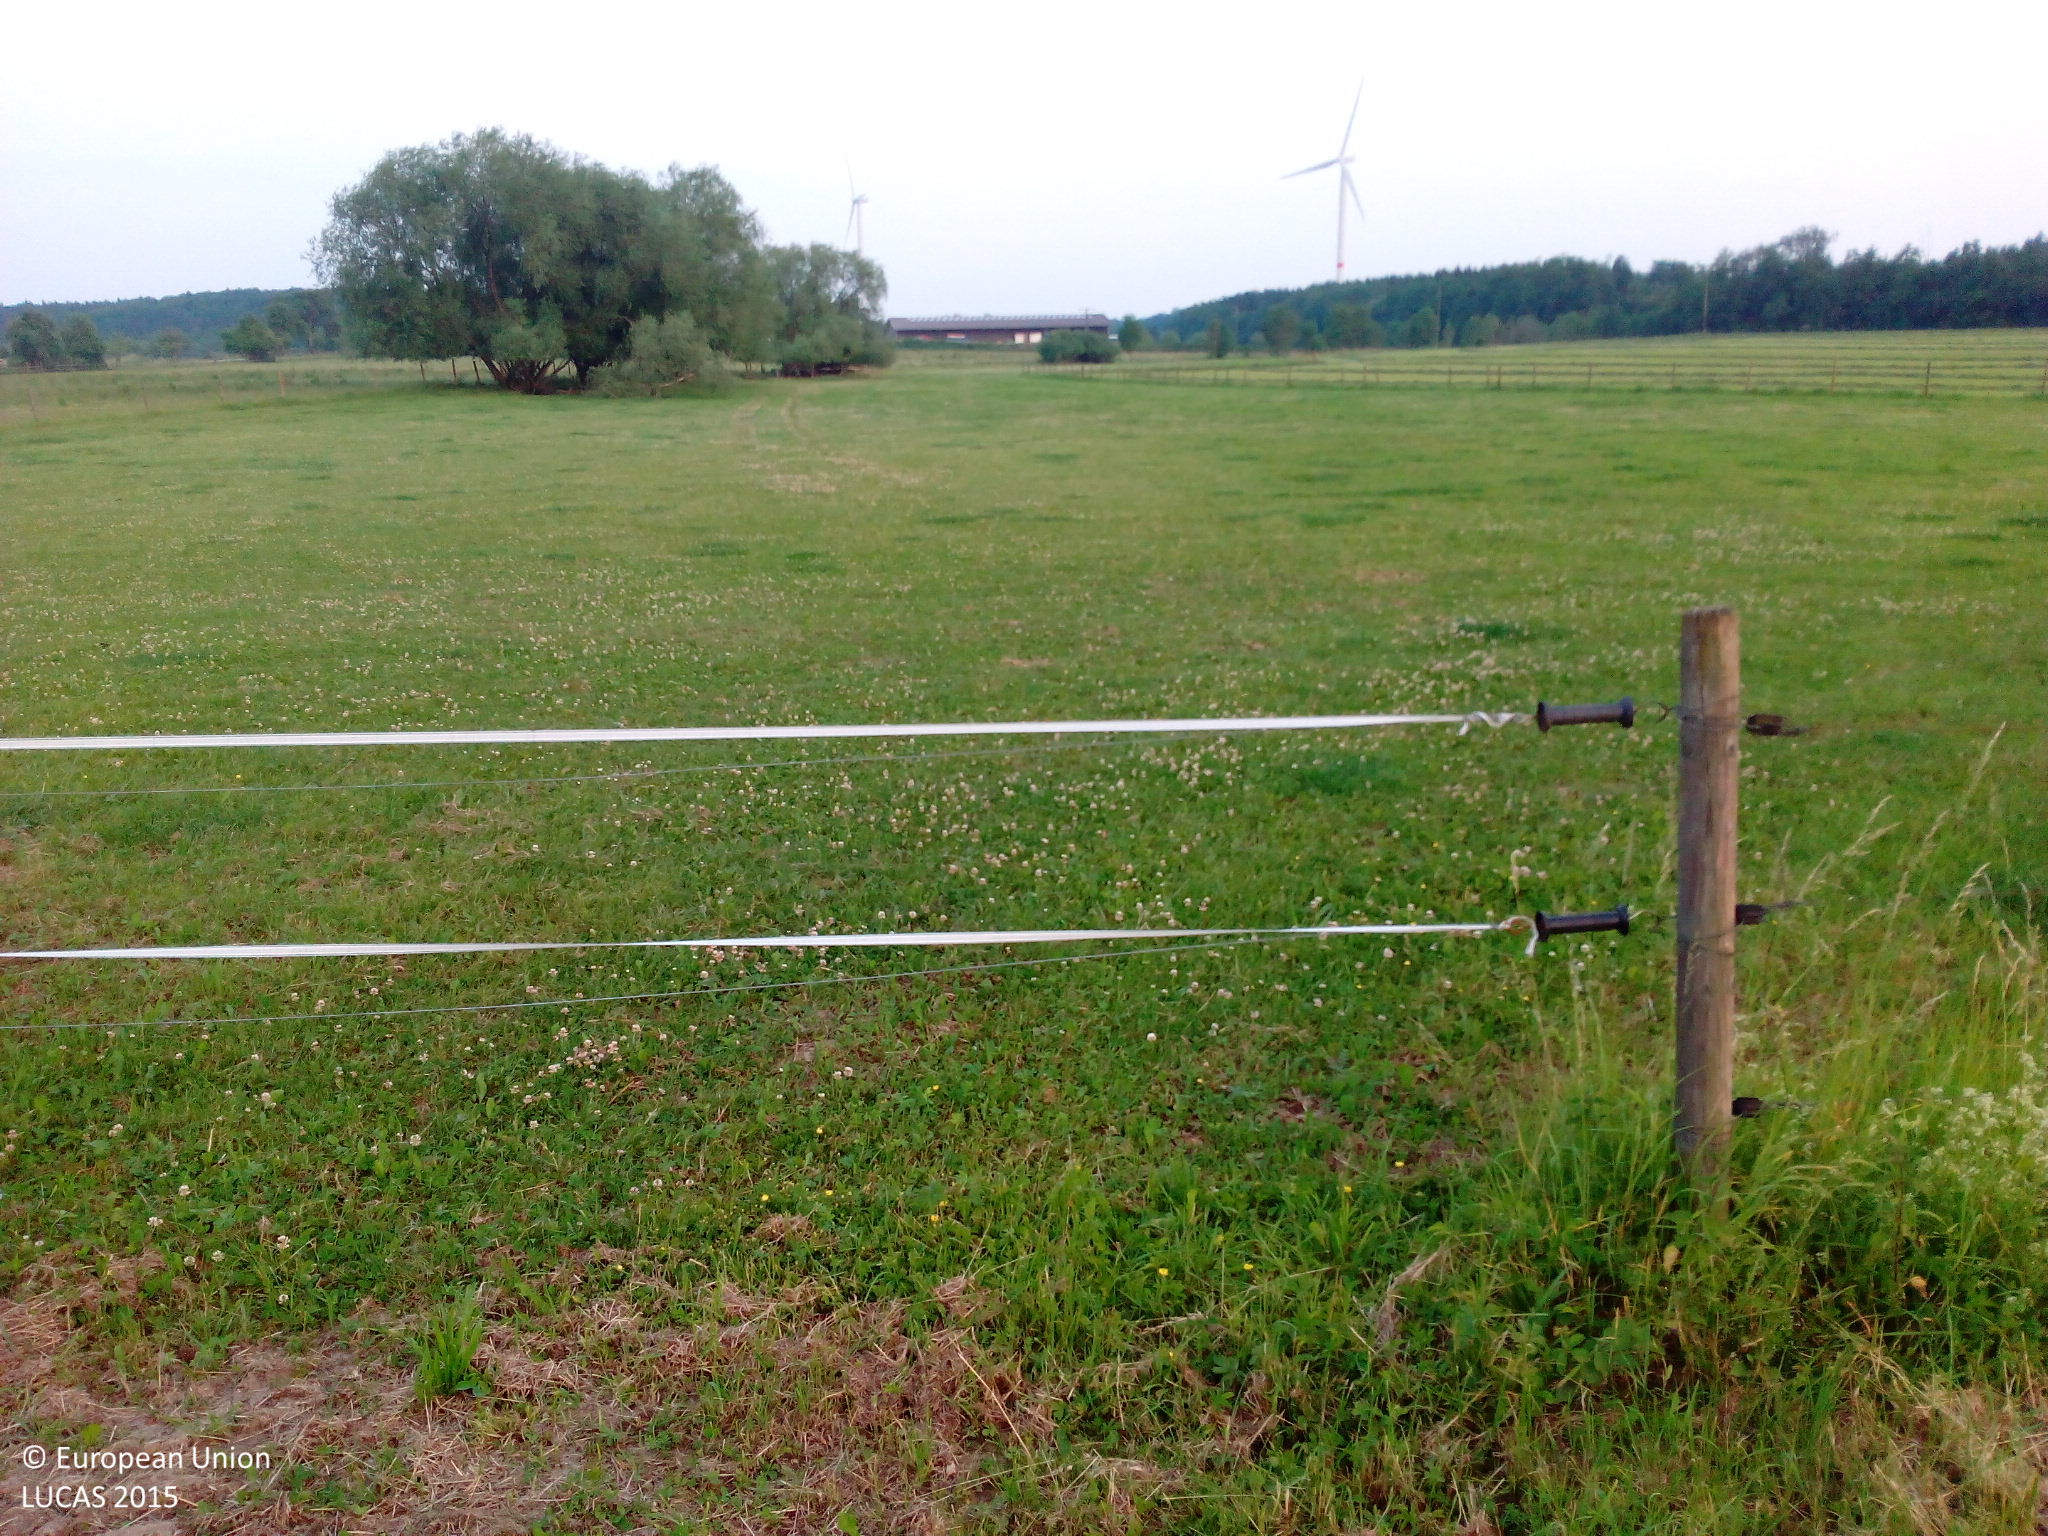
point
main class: Grassland
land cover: Grassland without tree/shrub cover
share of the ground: > 75 %
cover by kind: herbaceous plants 100 %
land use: Agriculture (excluding fallow land and kitchen gardens)
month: June
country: DE
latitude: 49.4625
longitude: 9.2690
